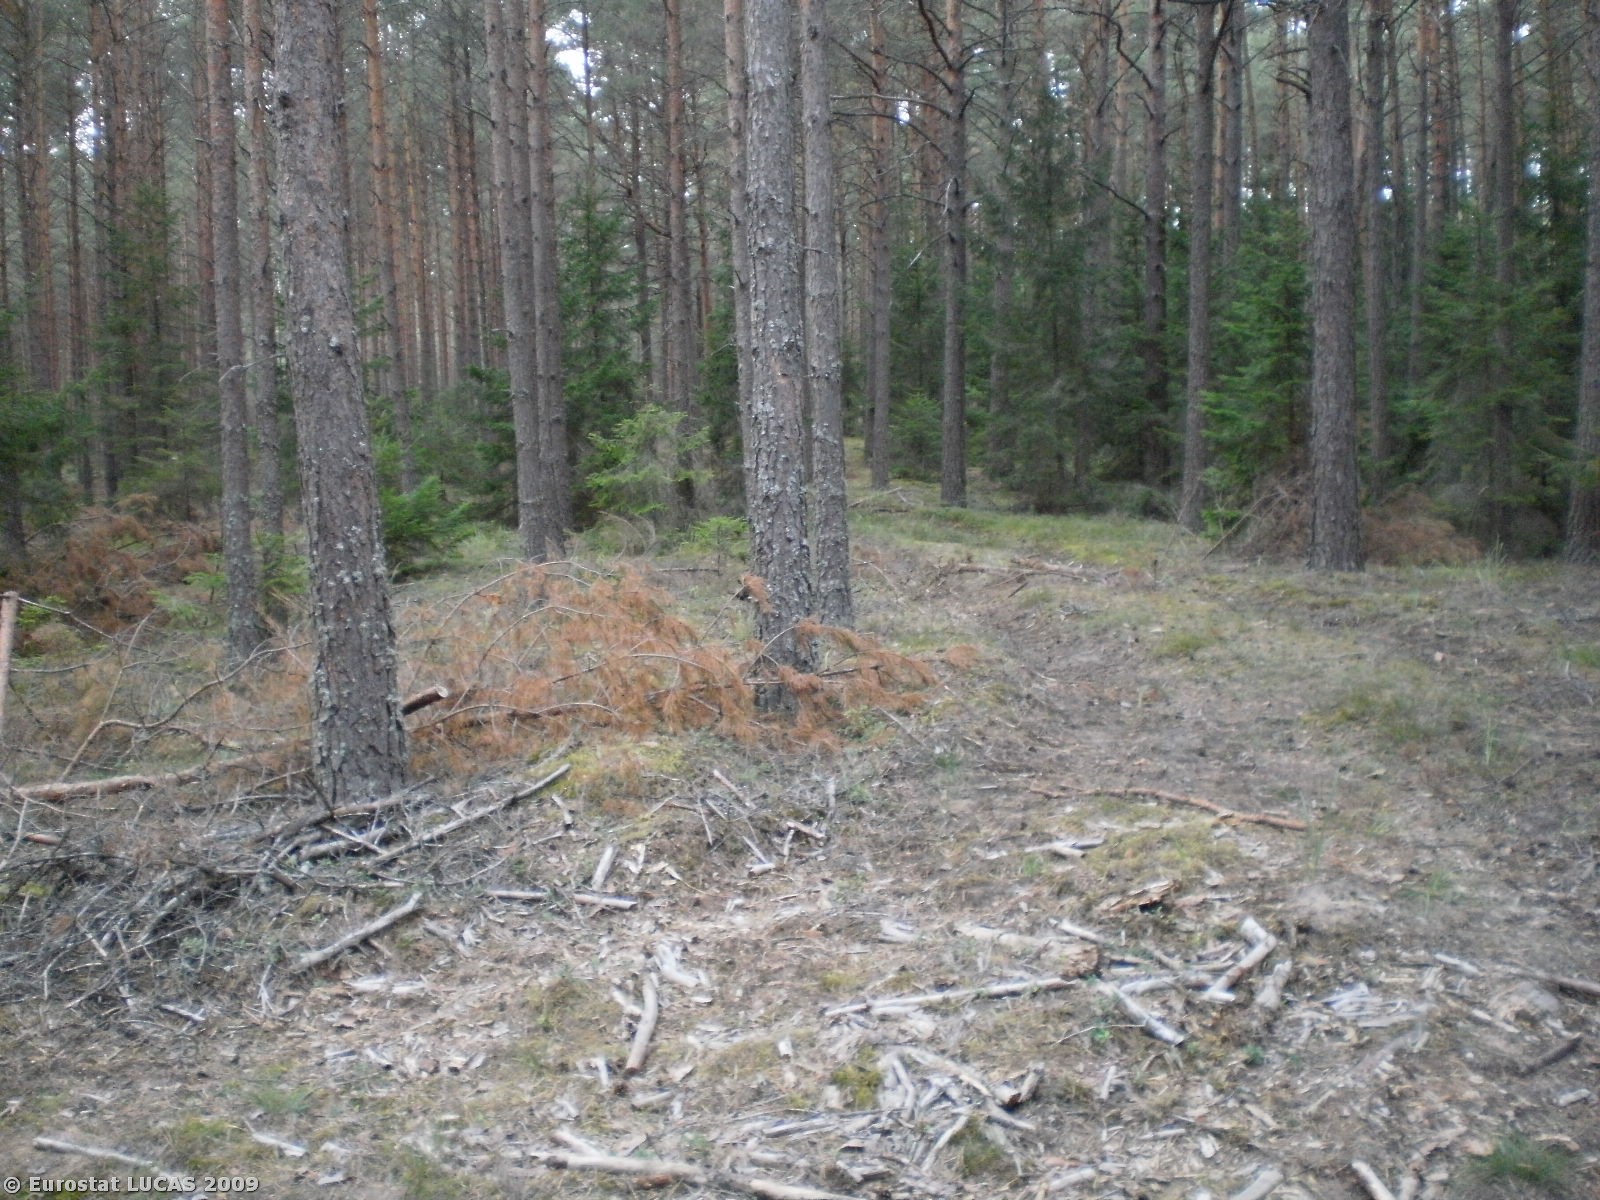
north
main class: Woodland
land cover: Coniferous woodland
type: hemiboreal forest and nemoral coniferous forest and mixed broadleaved-coniferous forest
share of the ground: > 75 %
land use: Forestry
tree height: > 5 m
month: September
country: PL
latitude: 53.6220
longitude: 21.6176
